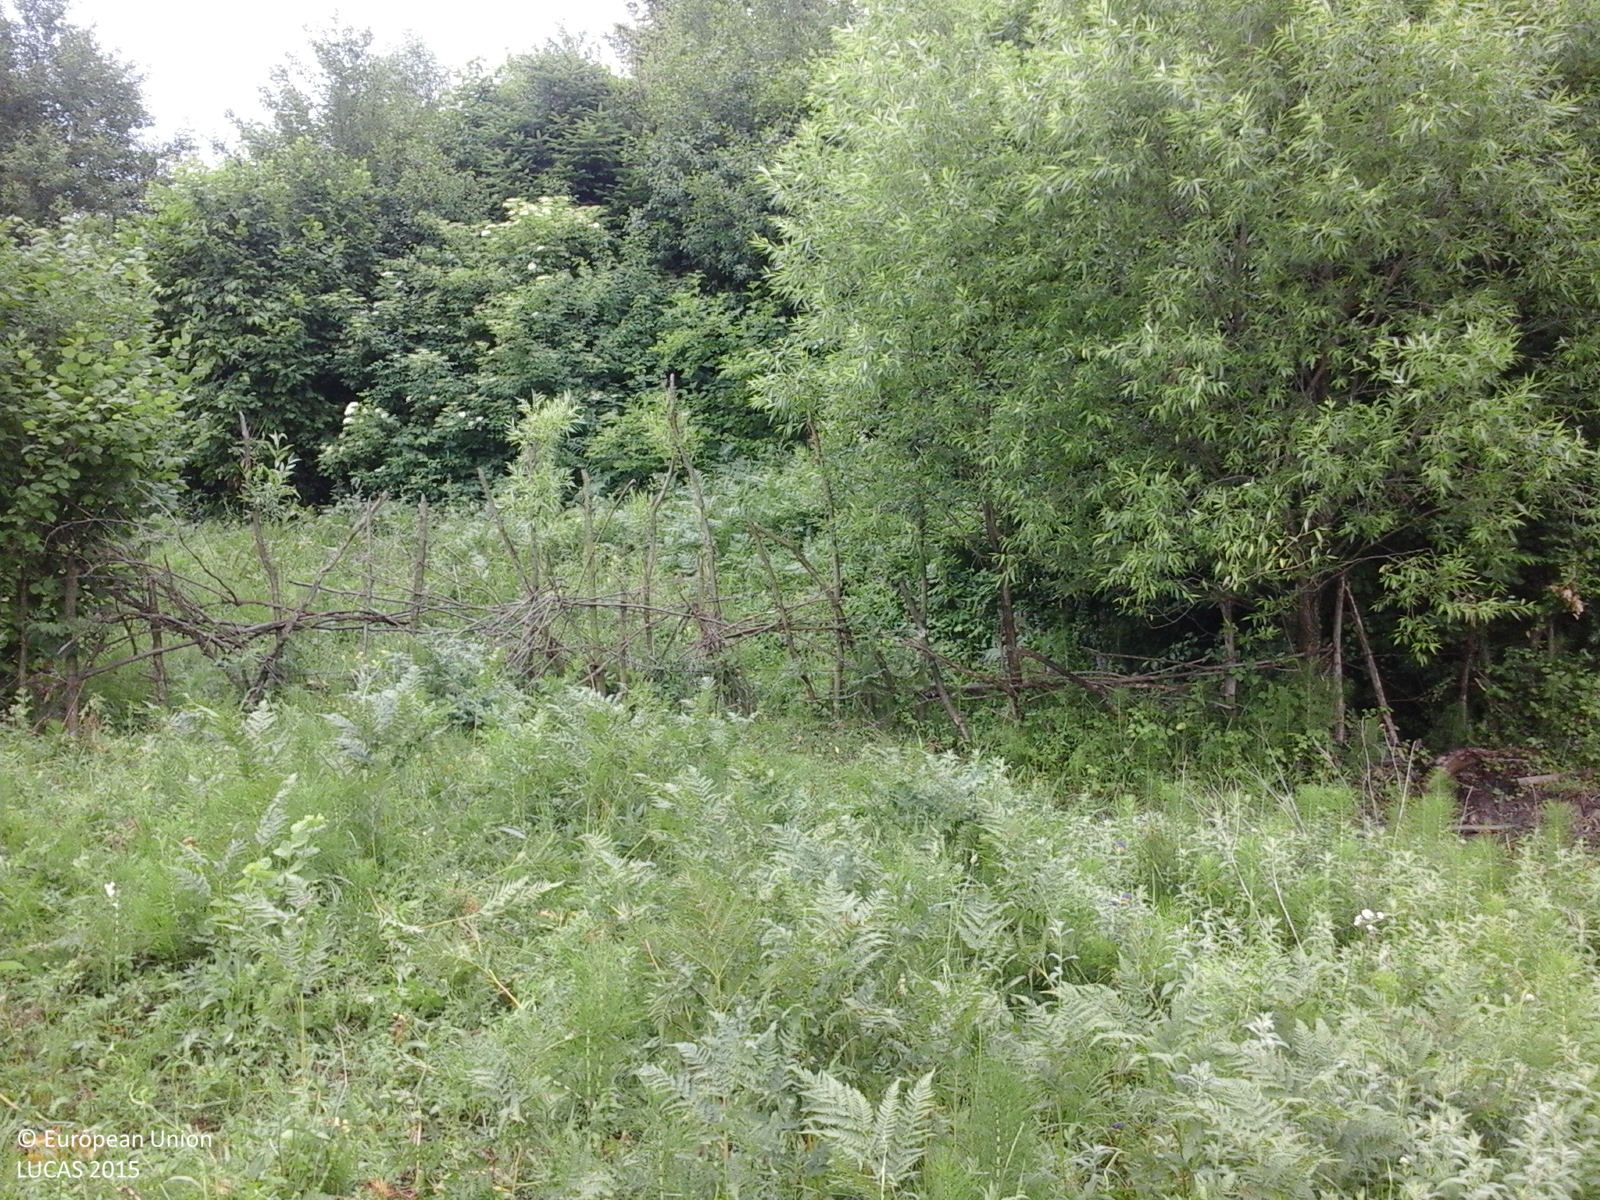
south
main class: Grassland
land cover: Spontaneously vegetated surfaces
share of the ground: > 75 %
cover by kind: herbaceous plants 100 %
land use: Agriculture (excluding fallow land and kitchen gardens)
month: June
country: RO
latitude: 47.3389
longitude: 26.2406
